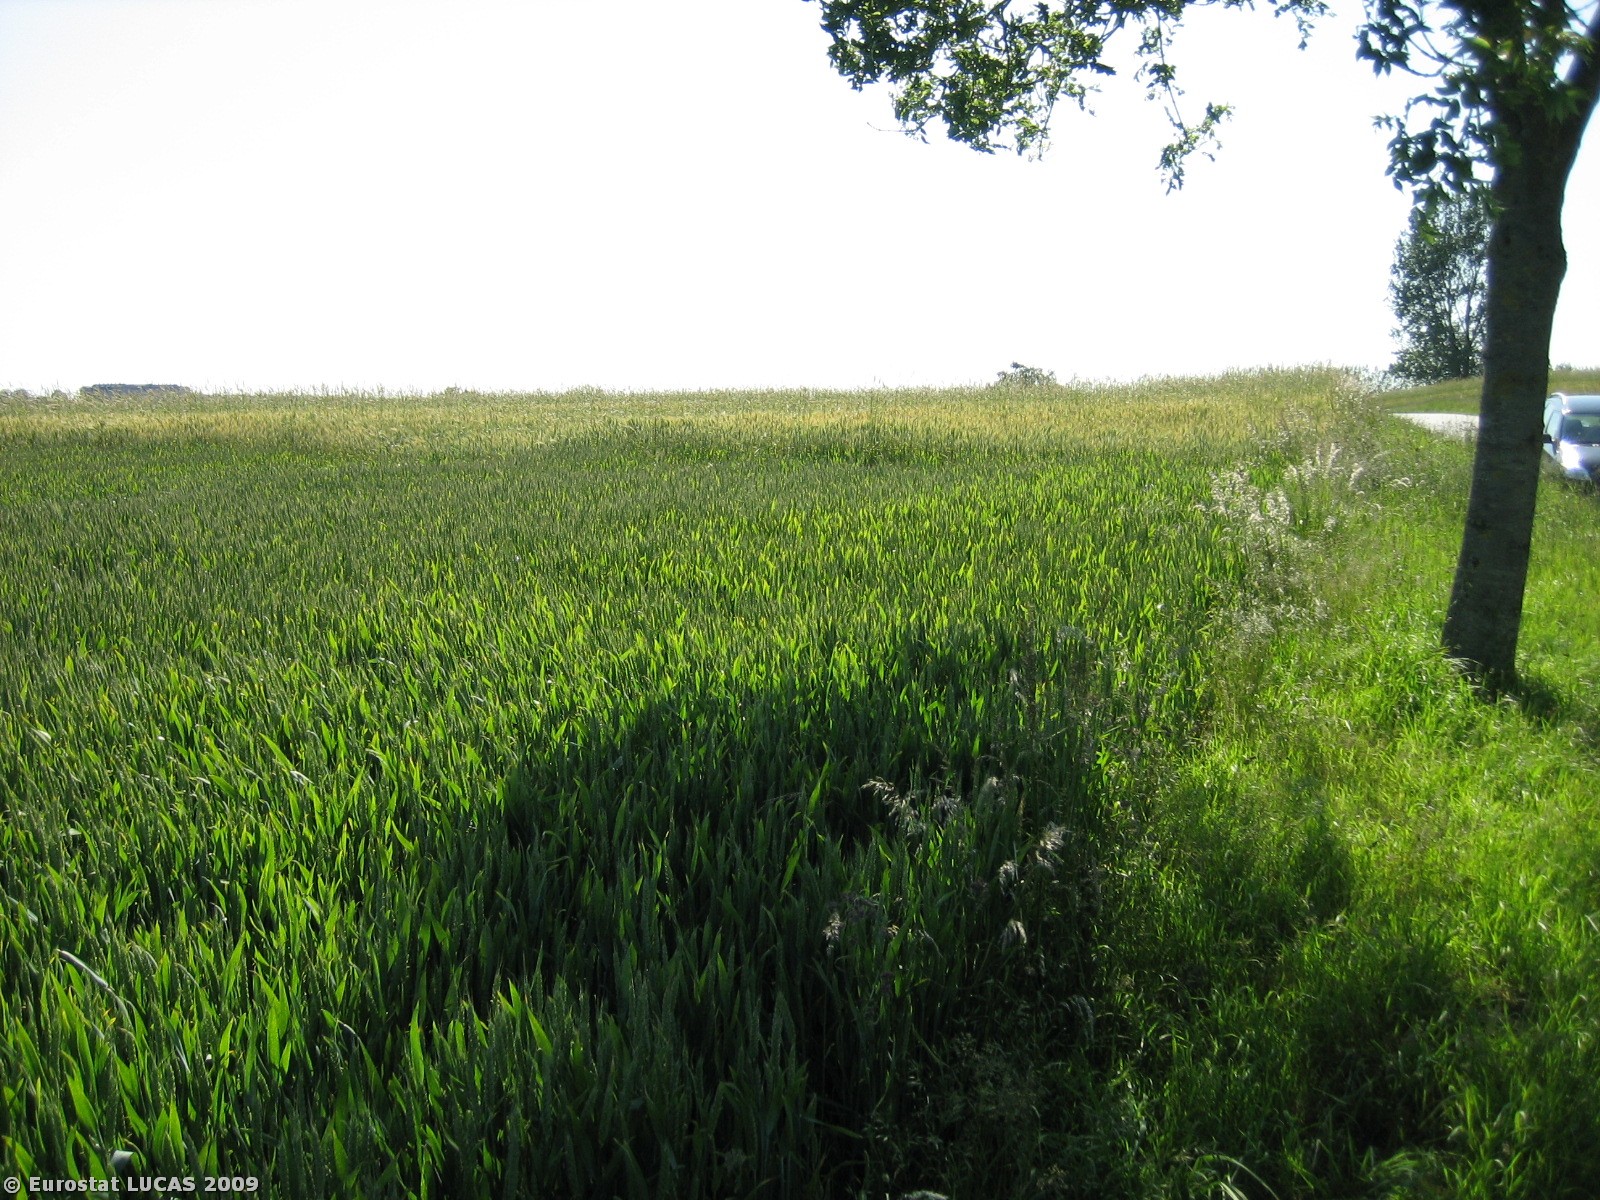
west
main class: Cropland
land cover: Common wheat
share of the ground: > 75 %
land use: Agriculture (excluding fallow land and kitchen gardens)
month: June
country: DK
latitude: 55.8821
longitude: 9.8563
